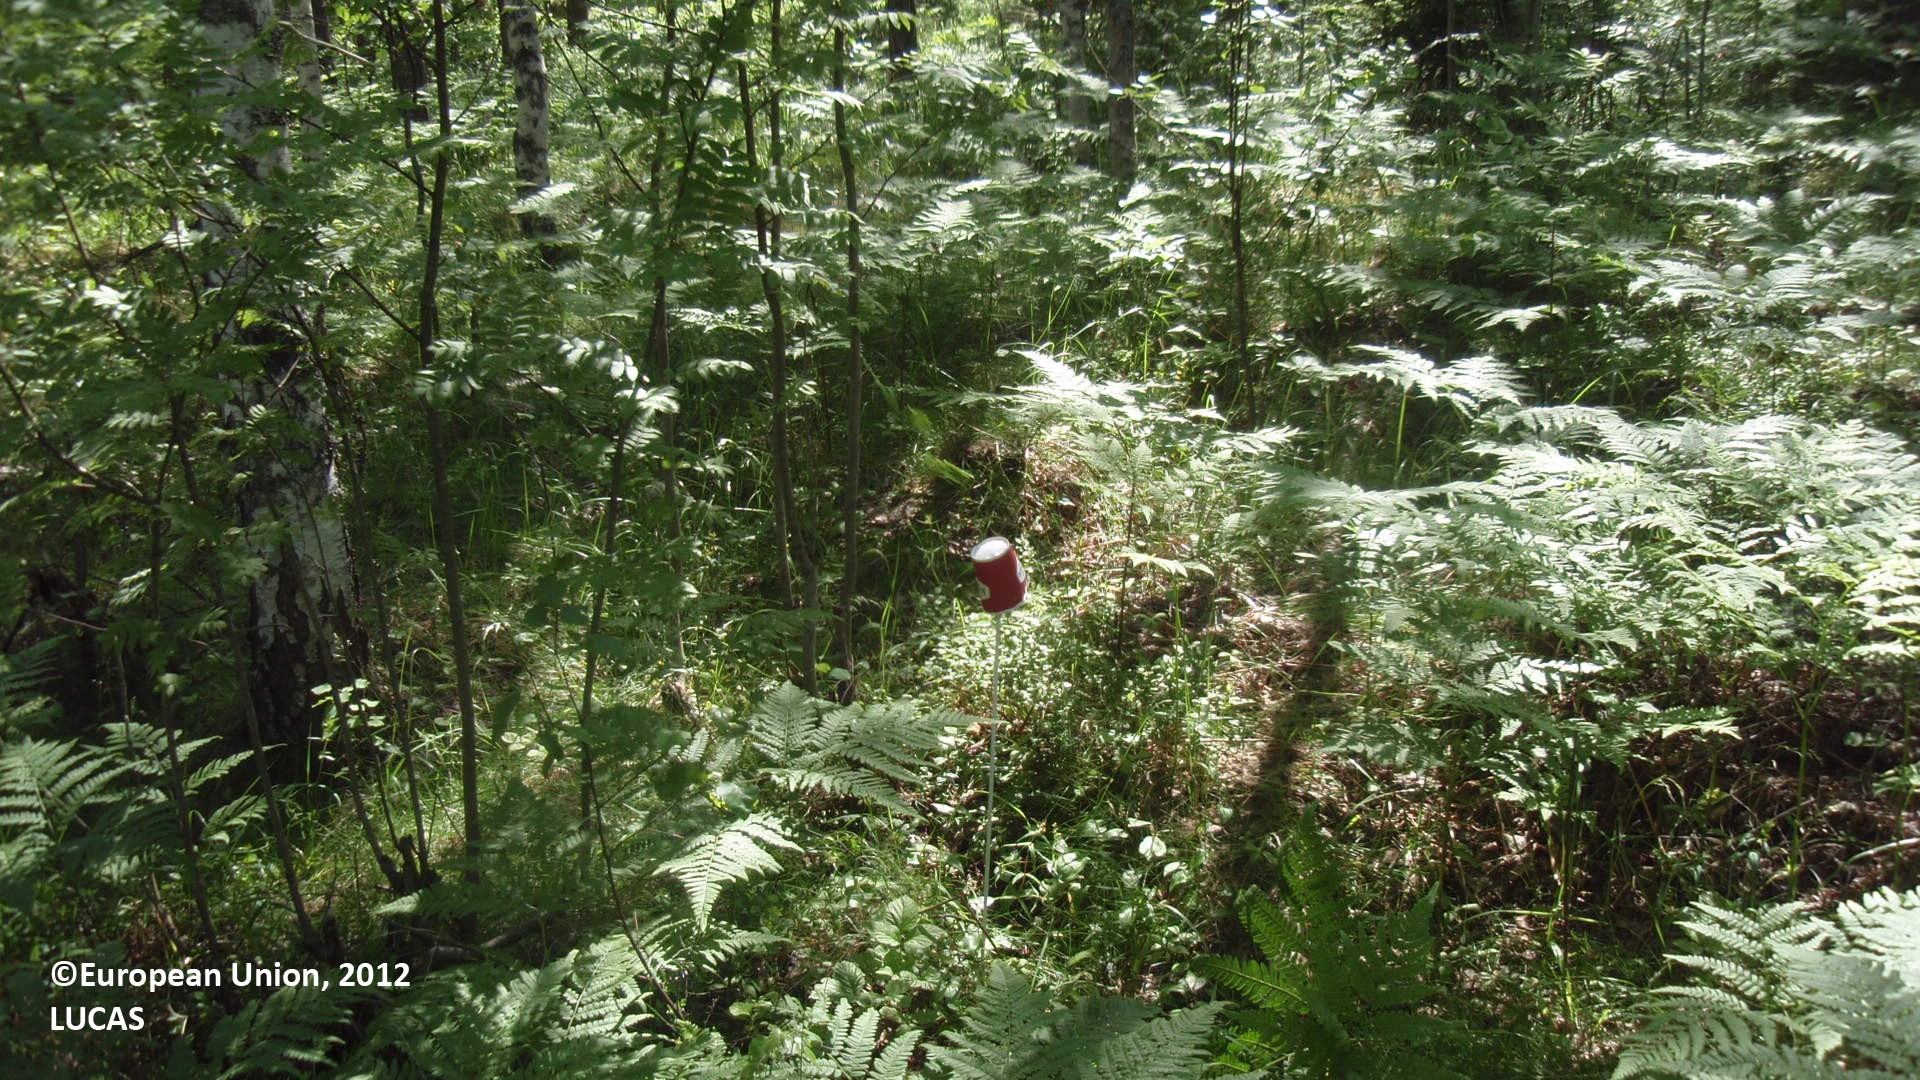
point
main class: Woodland
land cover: Other mixed woodland
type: boreal forest
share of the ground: > 75 %
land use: Forestry
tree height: > 5 m
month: July
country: FI
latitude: 61.7327
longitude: 28.3173
